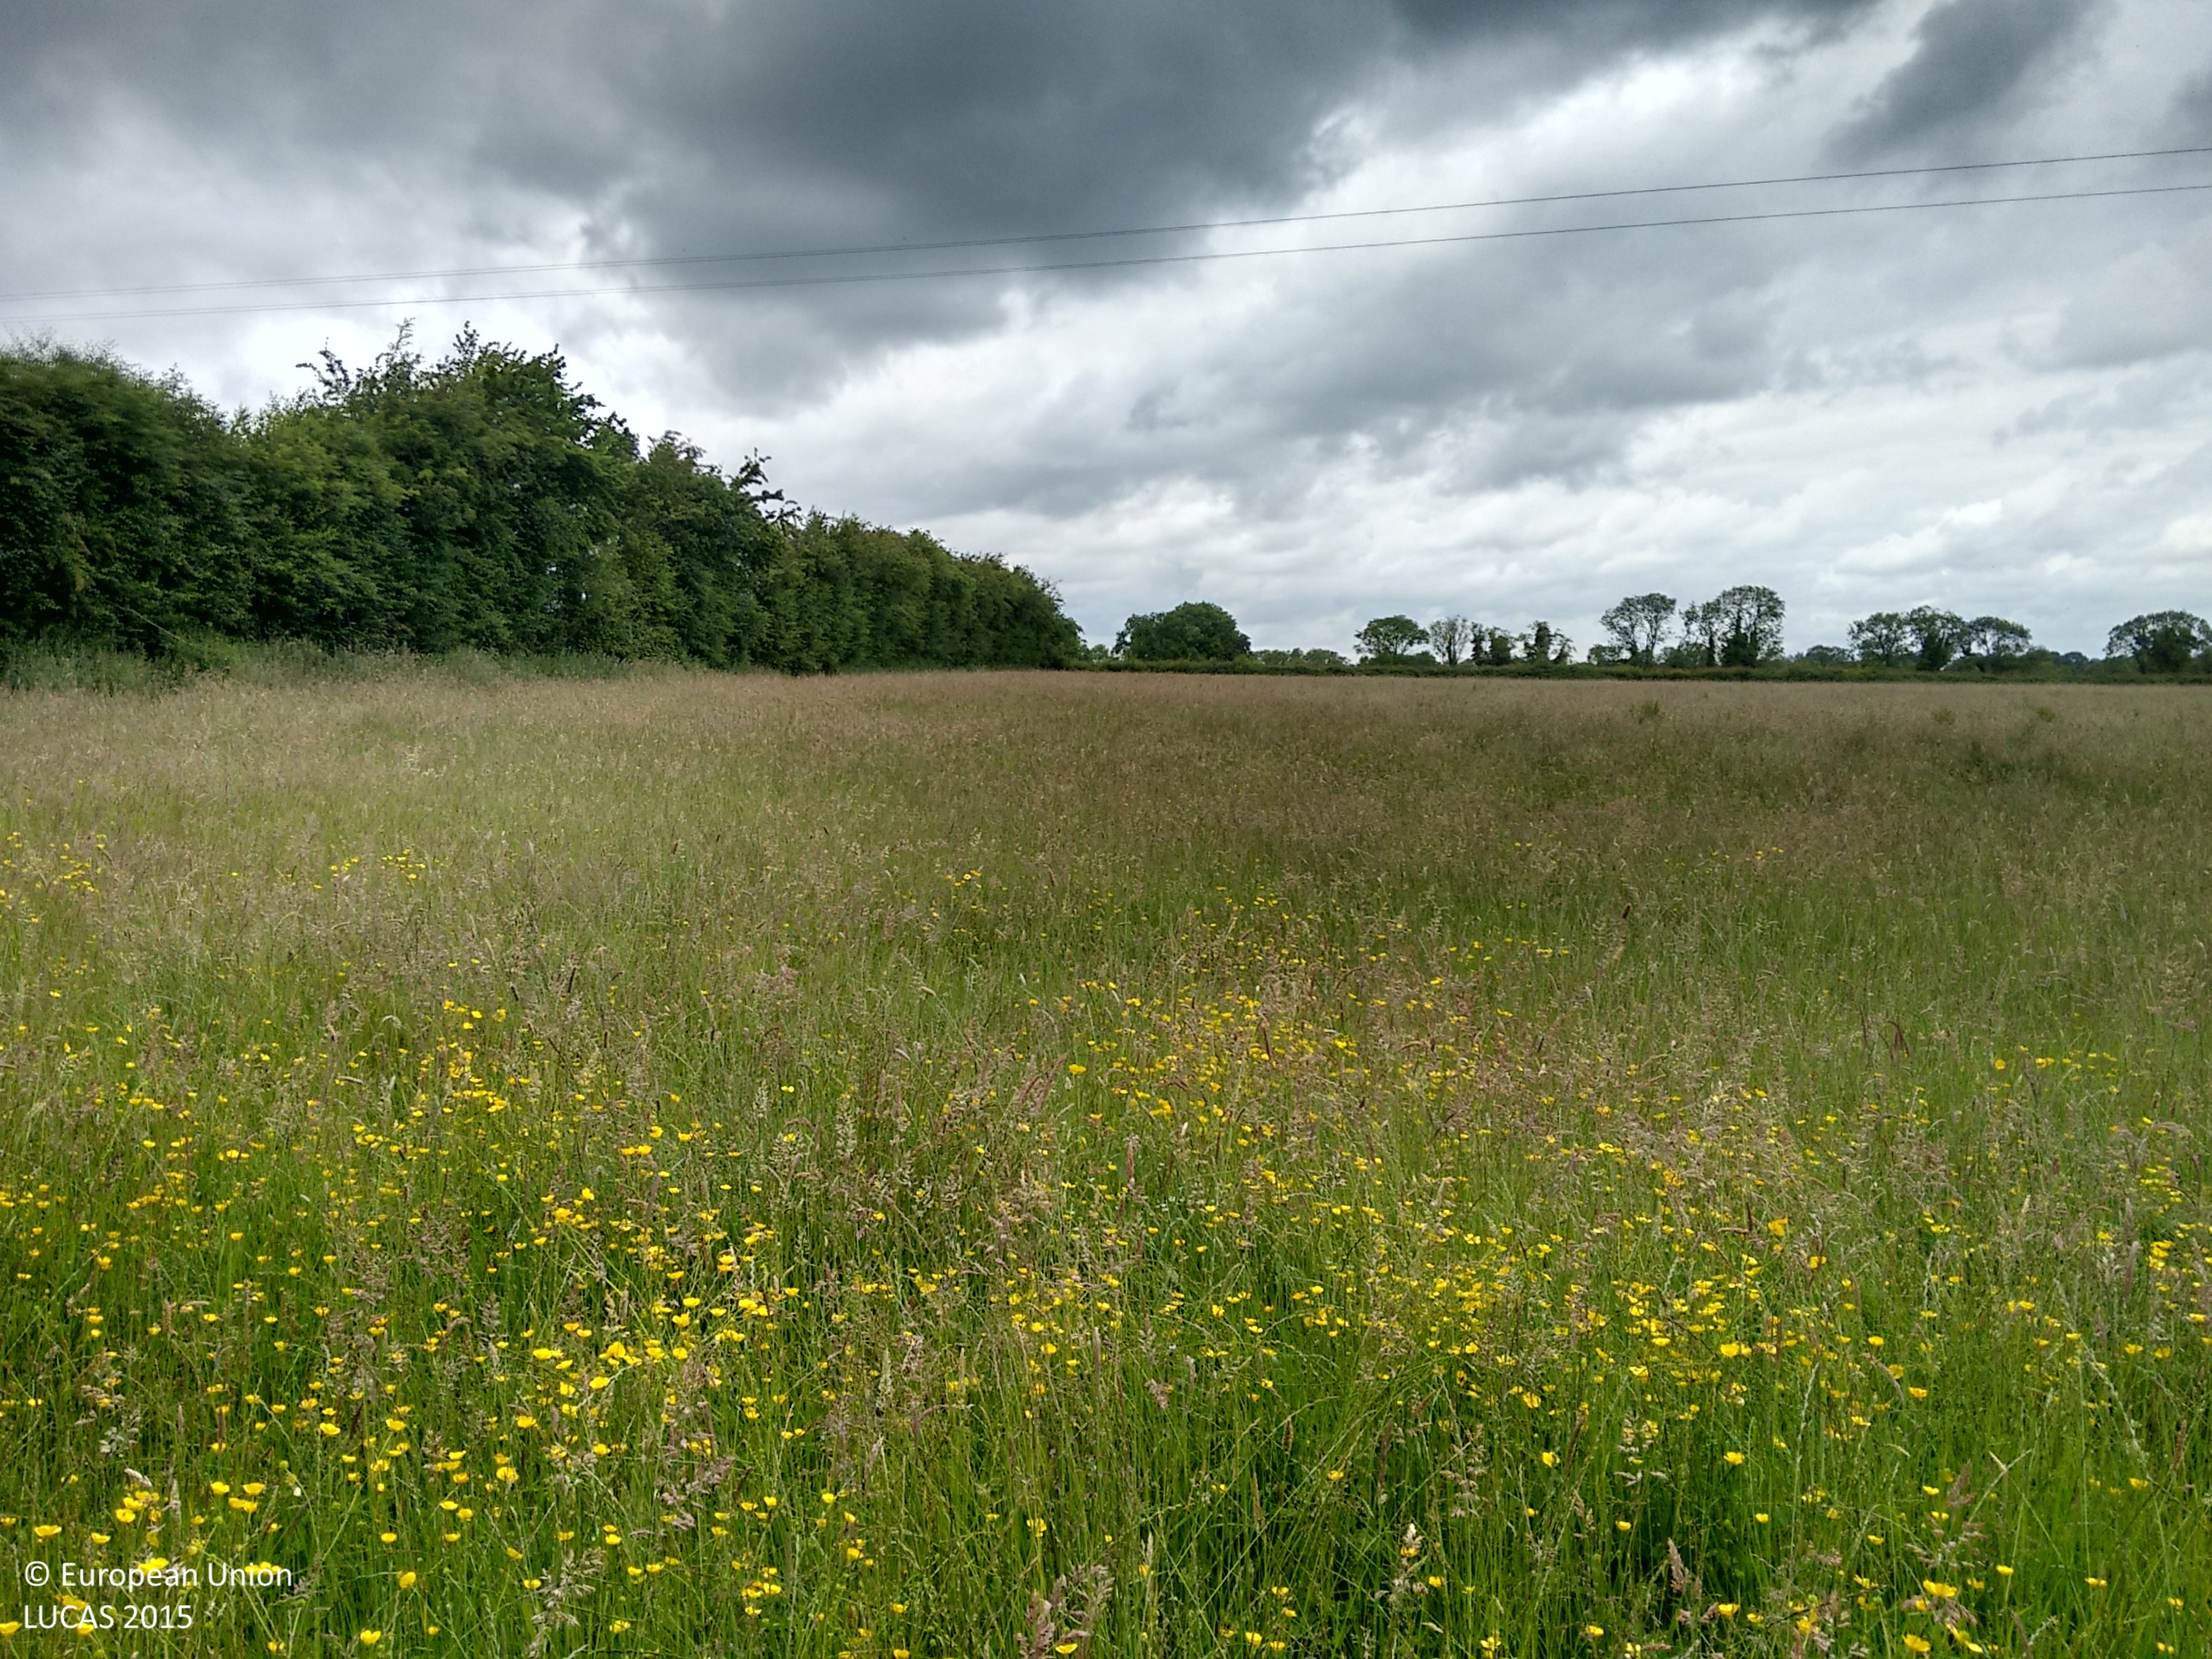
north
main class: Grassland
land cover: Grassland without tree/shrub cover
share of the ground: > 75 %
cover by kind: herbaceous plants 100 %
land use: Agriculture (excluding fallow land and kitchen gardens)
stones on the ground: < 10 %
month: June
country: IE
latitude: 53.6208
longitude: -6.7491
